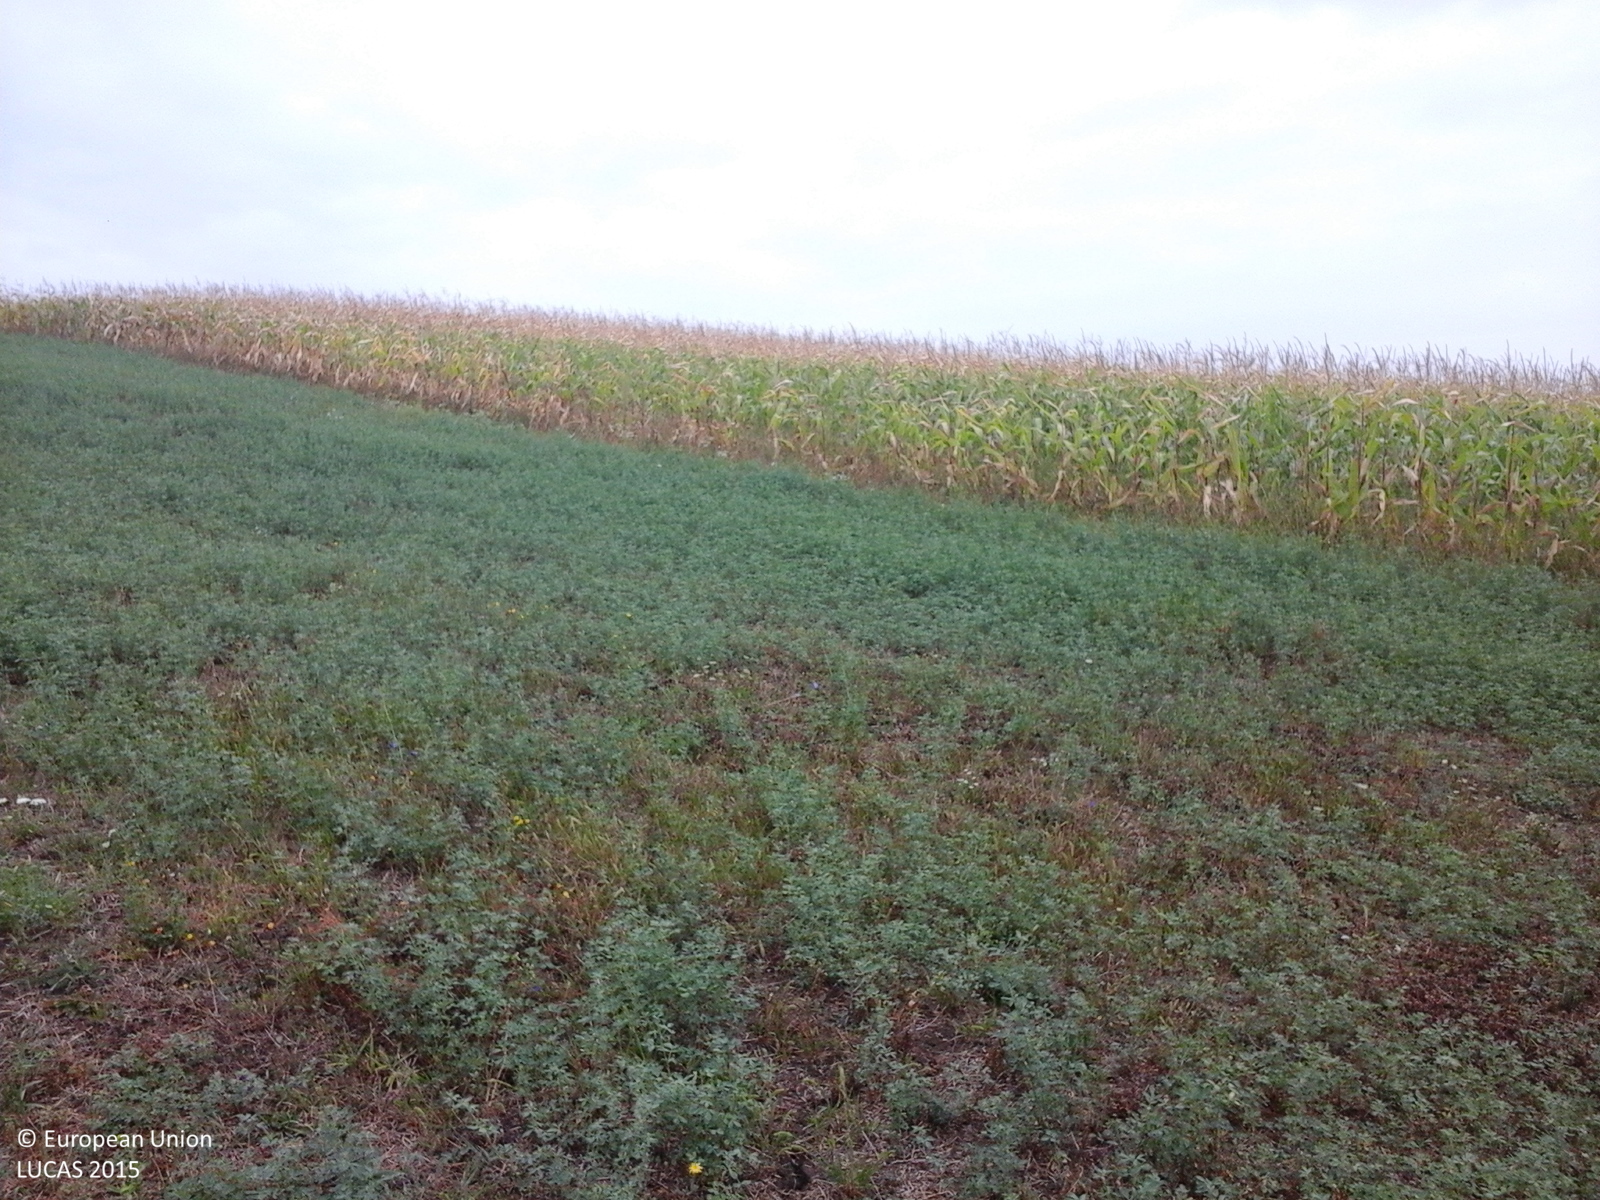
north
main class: Cropland
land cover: Lucerne
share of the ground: > 75 %
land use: Agriculture (excluding fallow land and kitchen gardens)
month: September
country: RO
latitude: 47.2463
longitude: 23.0249
